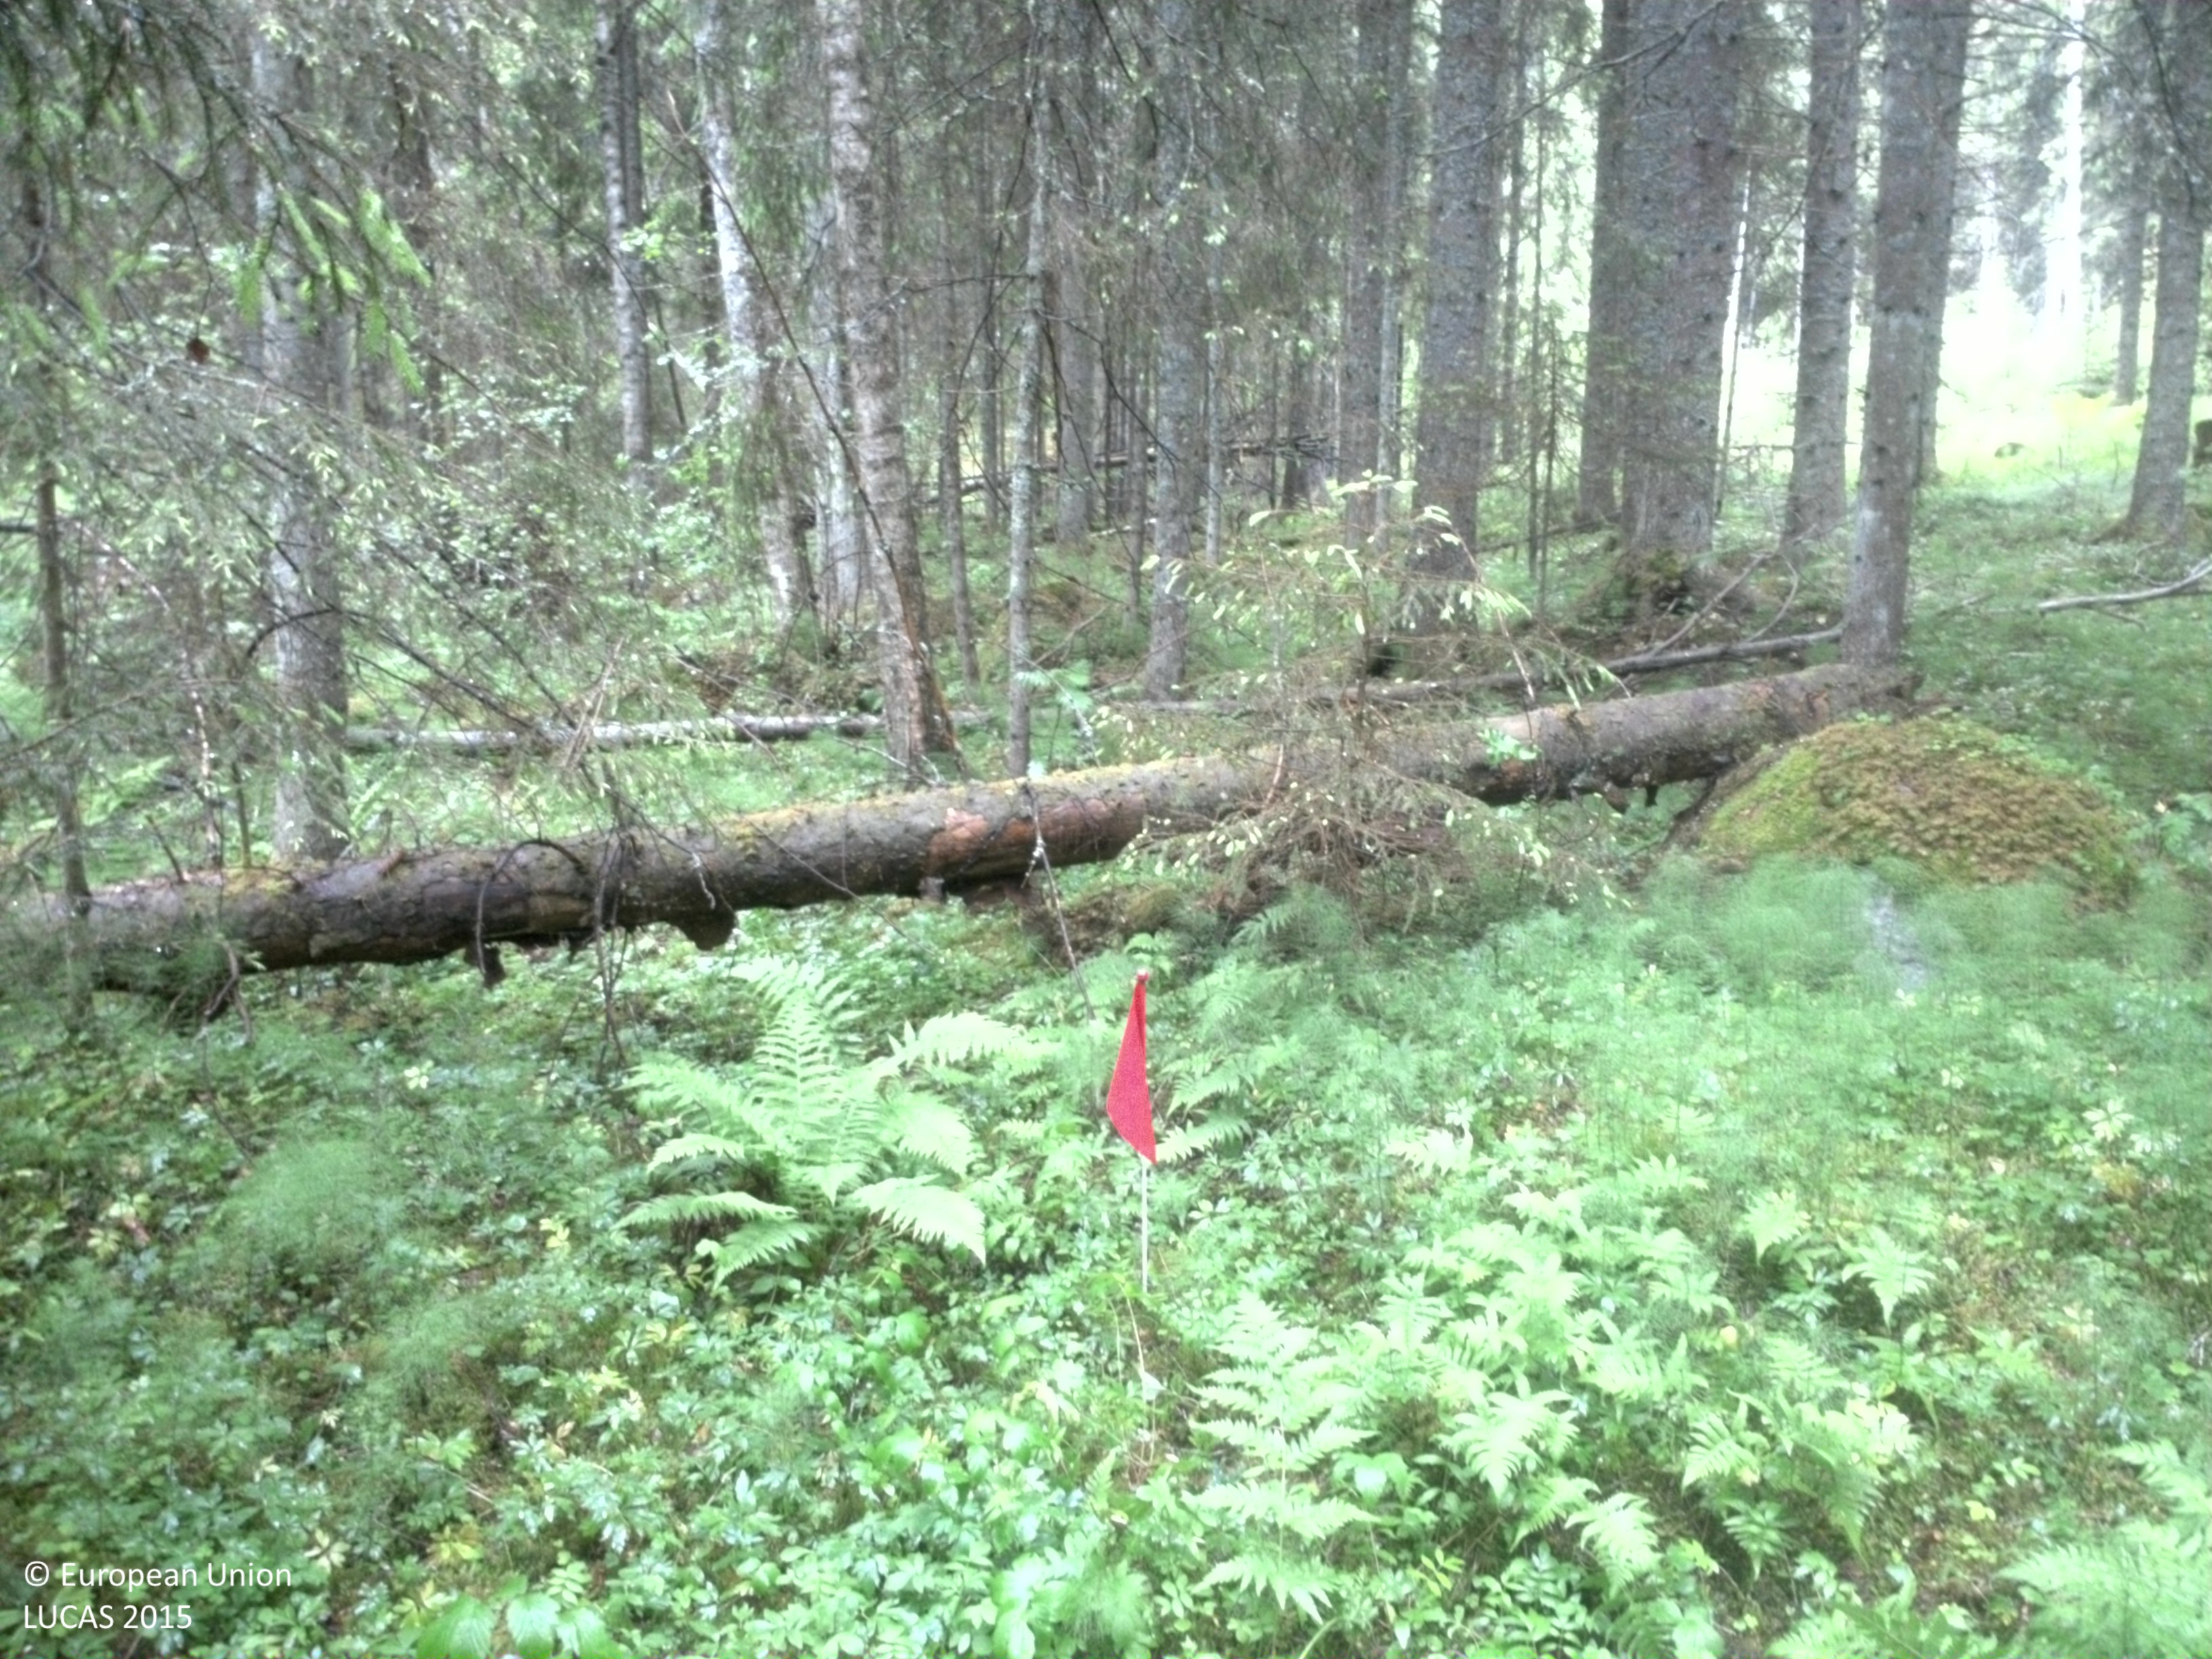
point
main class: Woodland
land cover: Spruce dominated coniferous woodland
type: boreal forest
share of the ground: 50 - 75 %
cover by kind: coniferous forest trees 70 %, lichens and mosses 15 %, shrubs 10 %, broadleaved forest trees 5 %
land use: Forestry
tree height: > 5 m
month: June
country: SE
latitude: 59.7310
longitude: 12.2172
